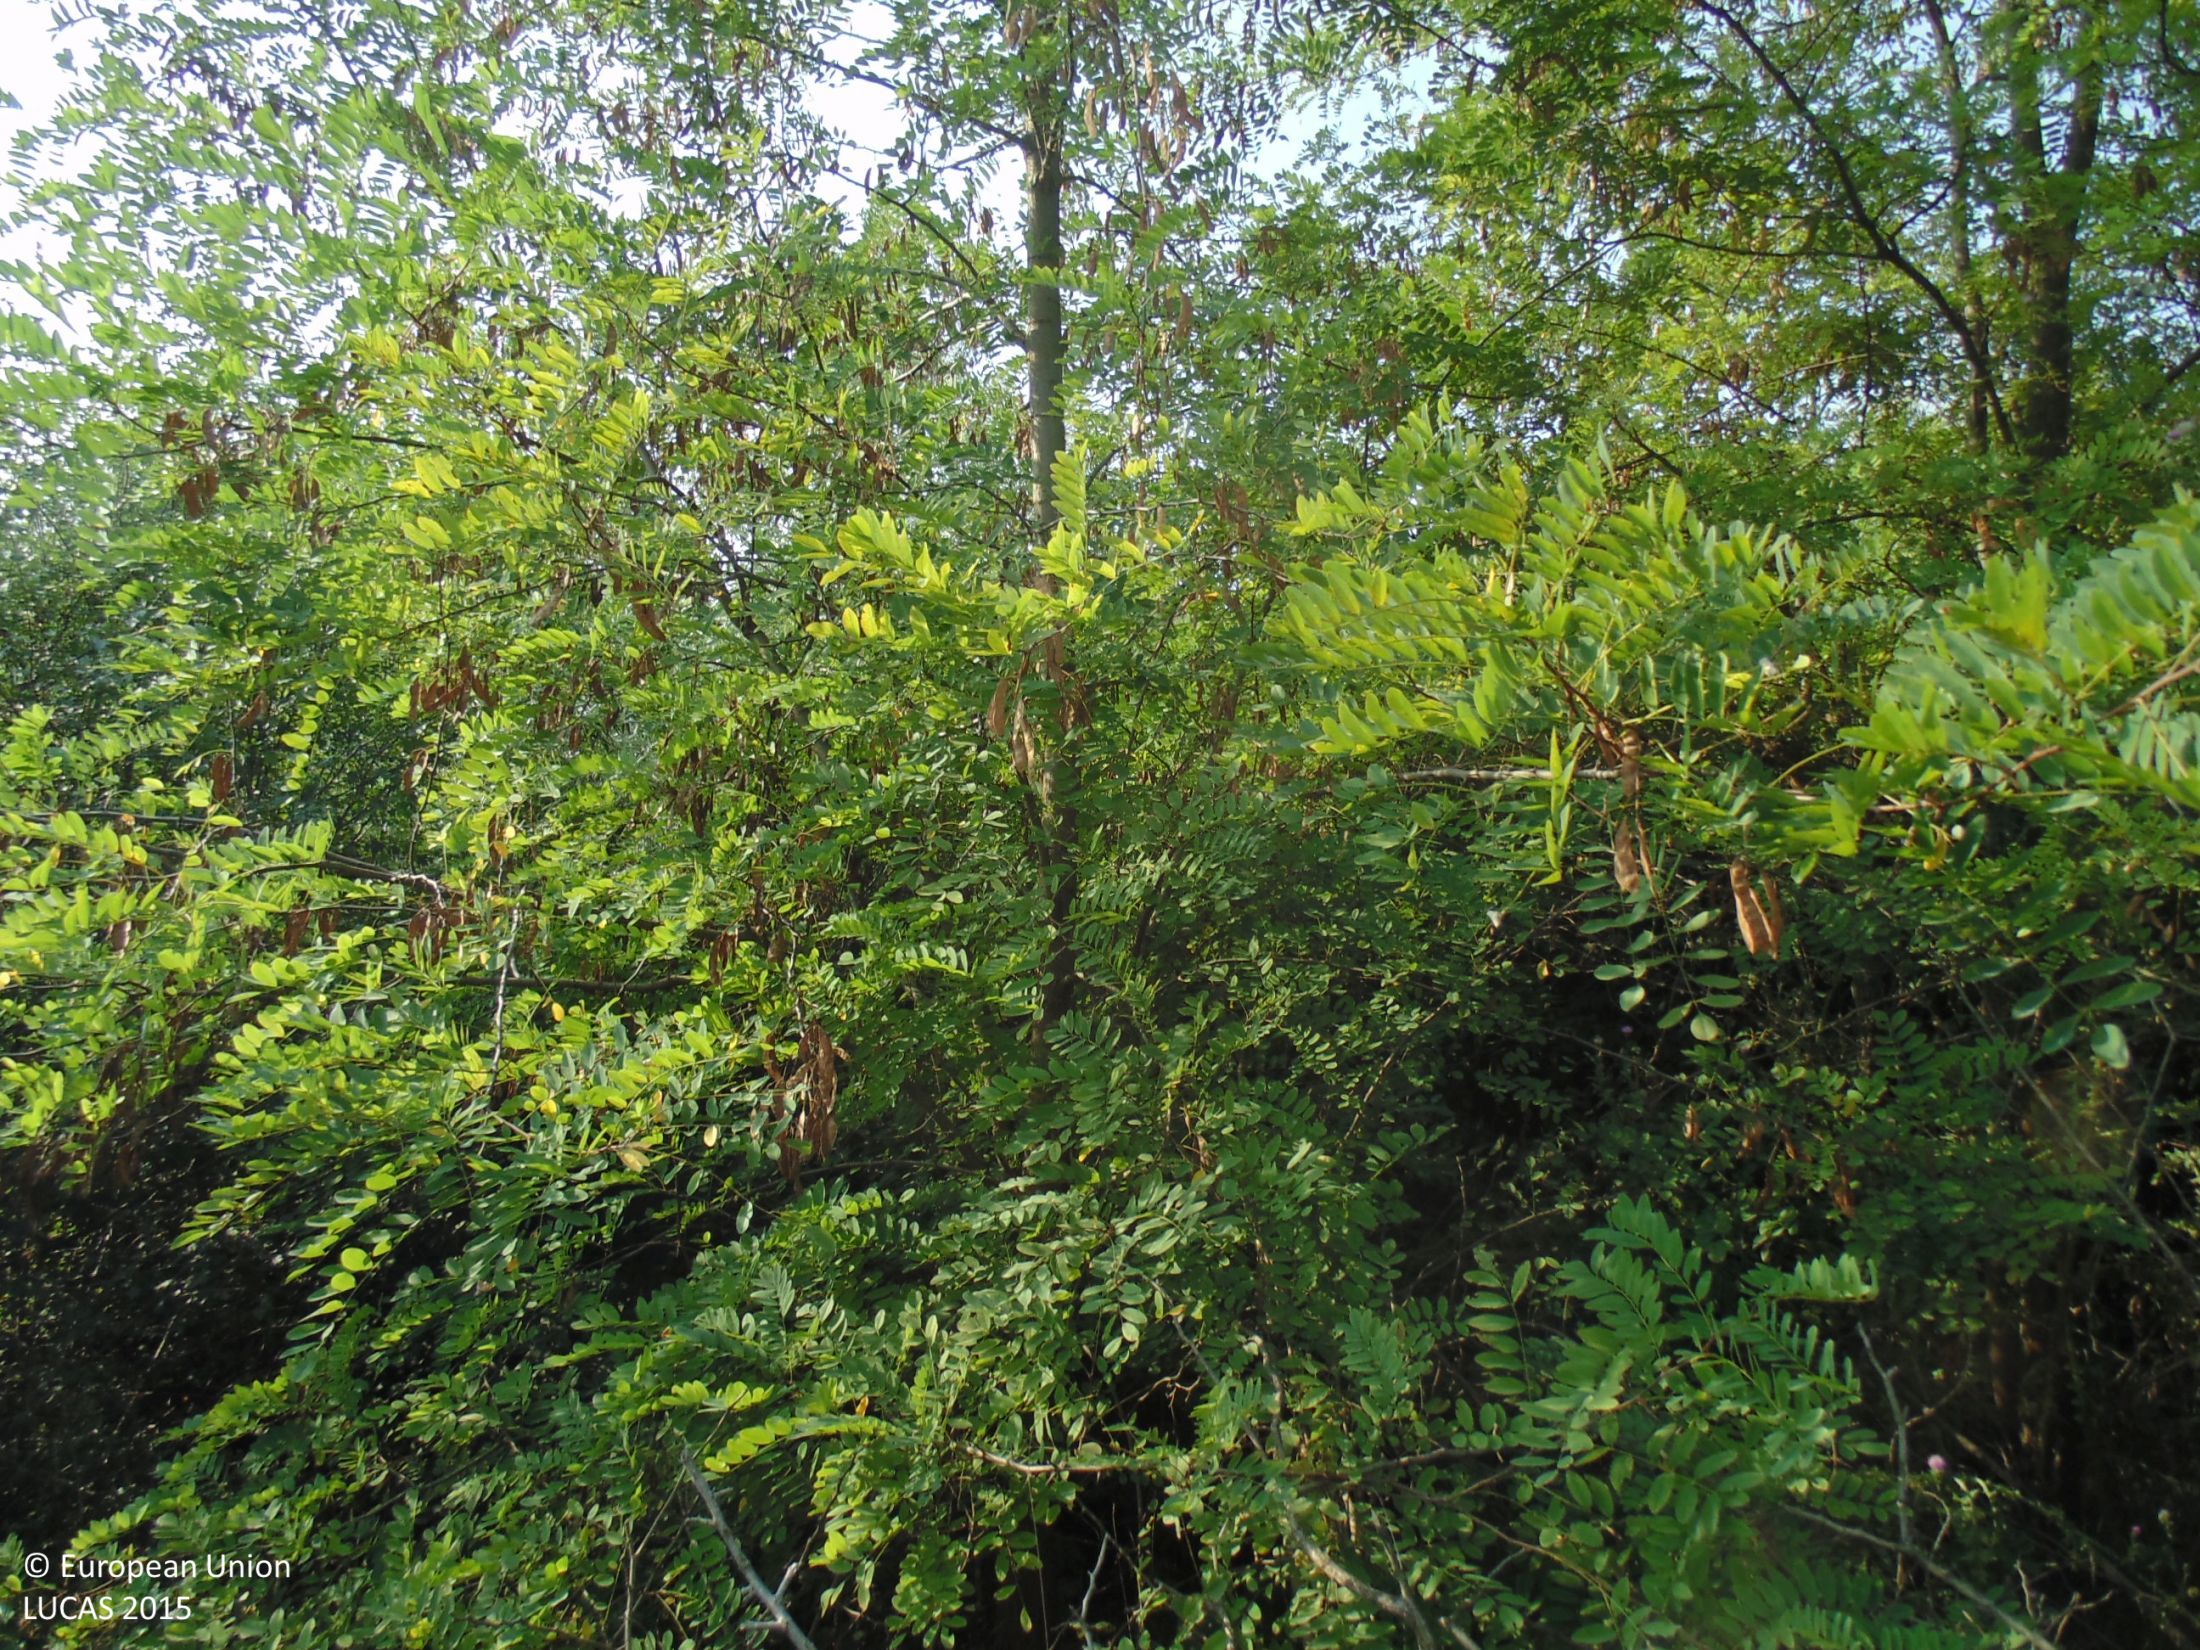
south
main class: Woodland
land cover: Broadleaved woodland
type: mesophytic deciduous forest
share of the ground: > 75 %
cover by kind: broadleaved forest trees 85 %, unconsolidated bare surface 10 %, shrubs 5 %
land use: Forestry
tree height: > 5 m
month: August
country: BG
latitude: 44.0112
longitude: 27.3845
